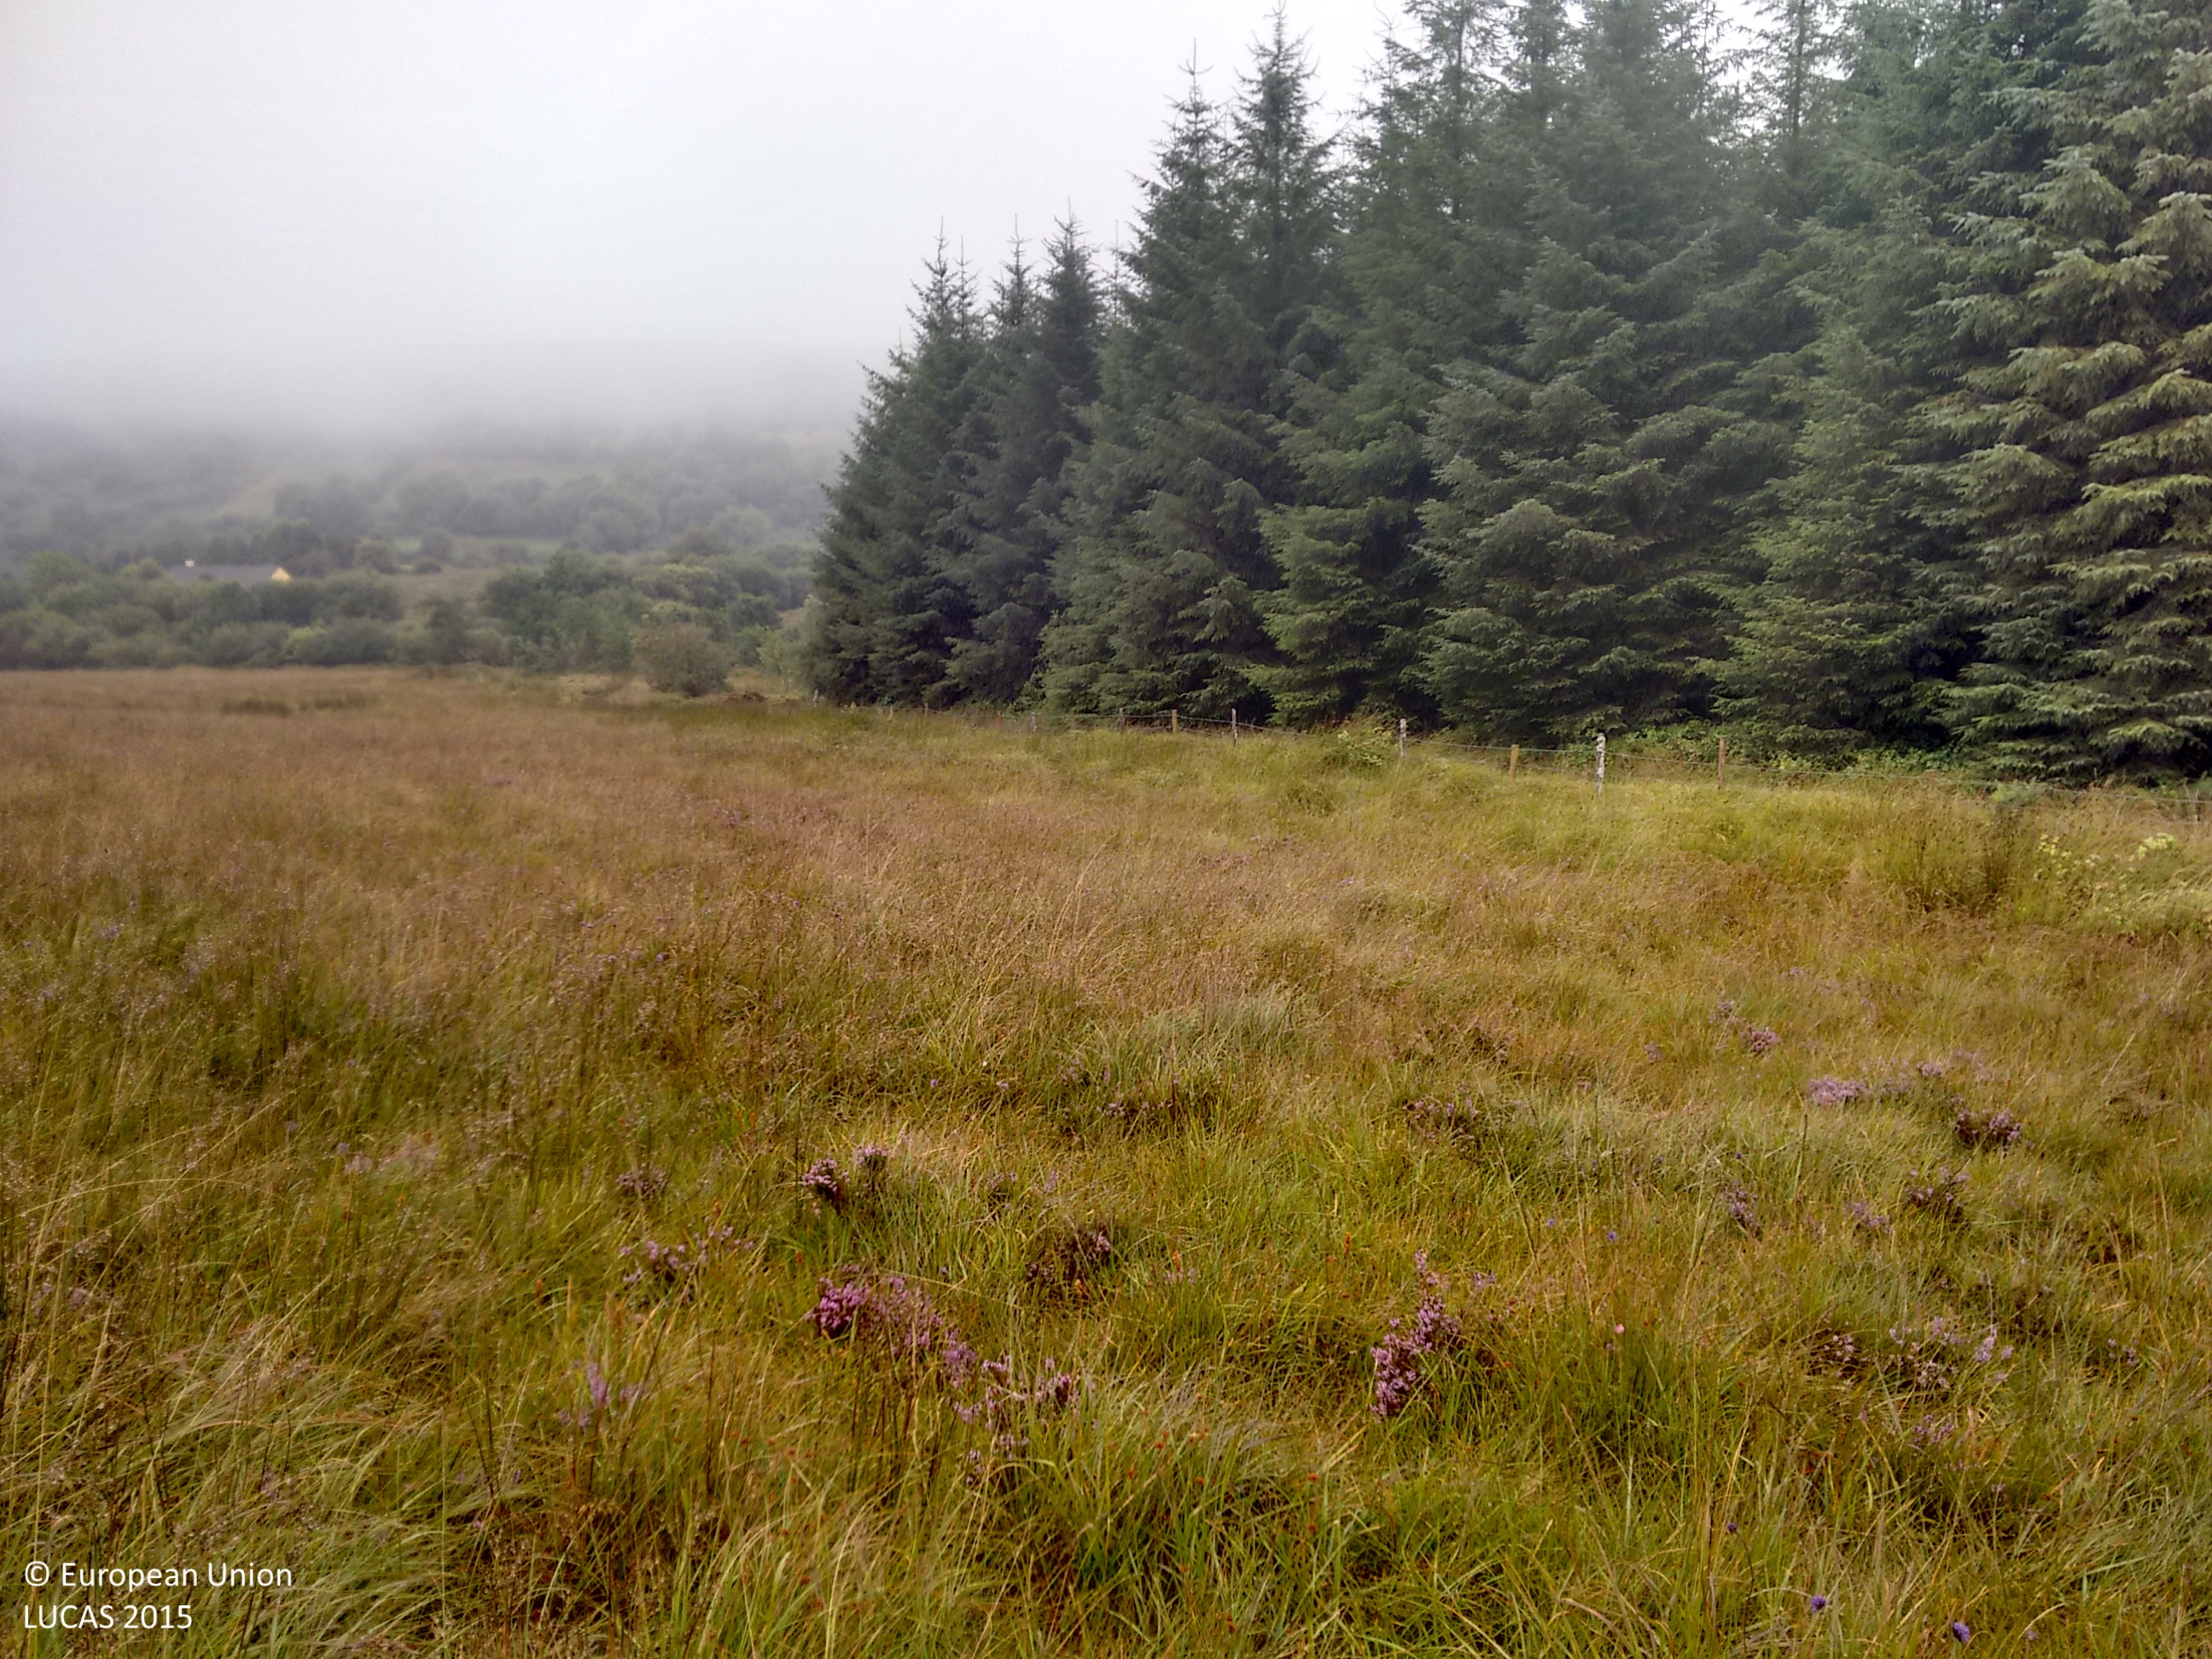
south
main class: Grassland
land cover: Grassland without tree/shrub cover
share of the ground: > 75 %
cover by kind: herbaceous plants 100 %
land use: Agriculture (excluding fallow land and kitchen gardens)
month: September
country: IE
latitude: 52.7387
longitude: -8.7007
